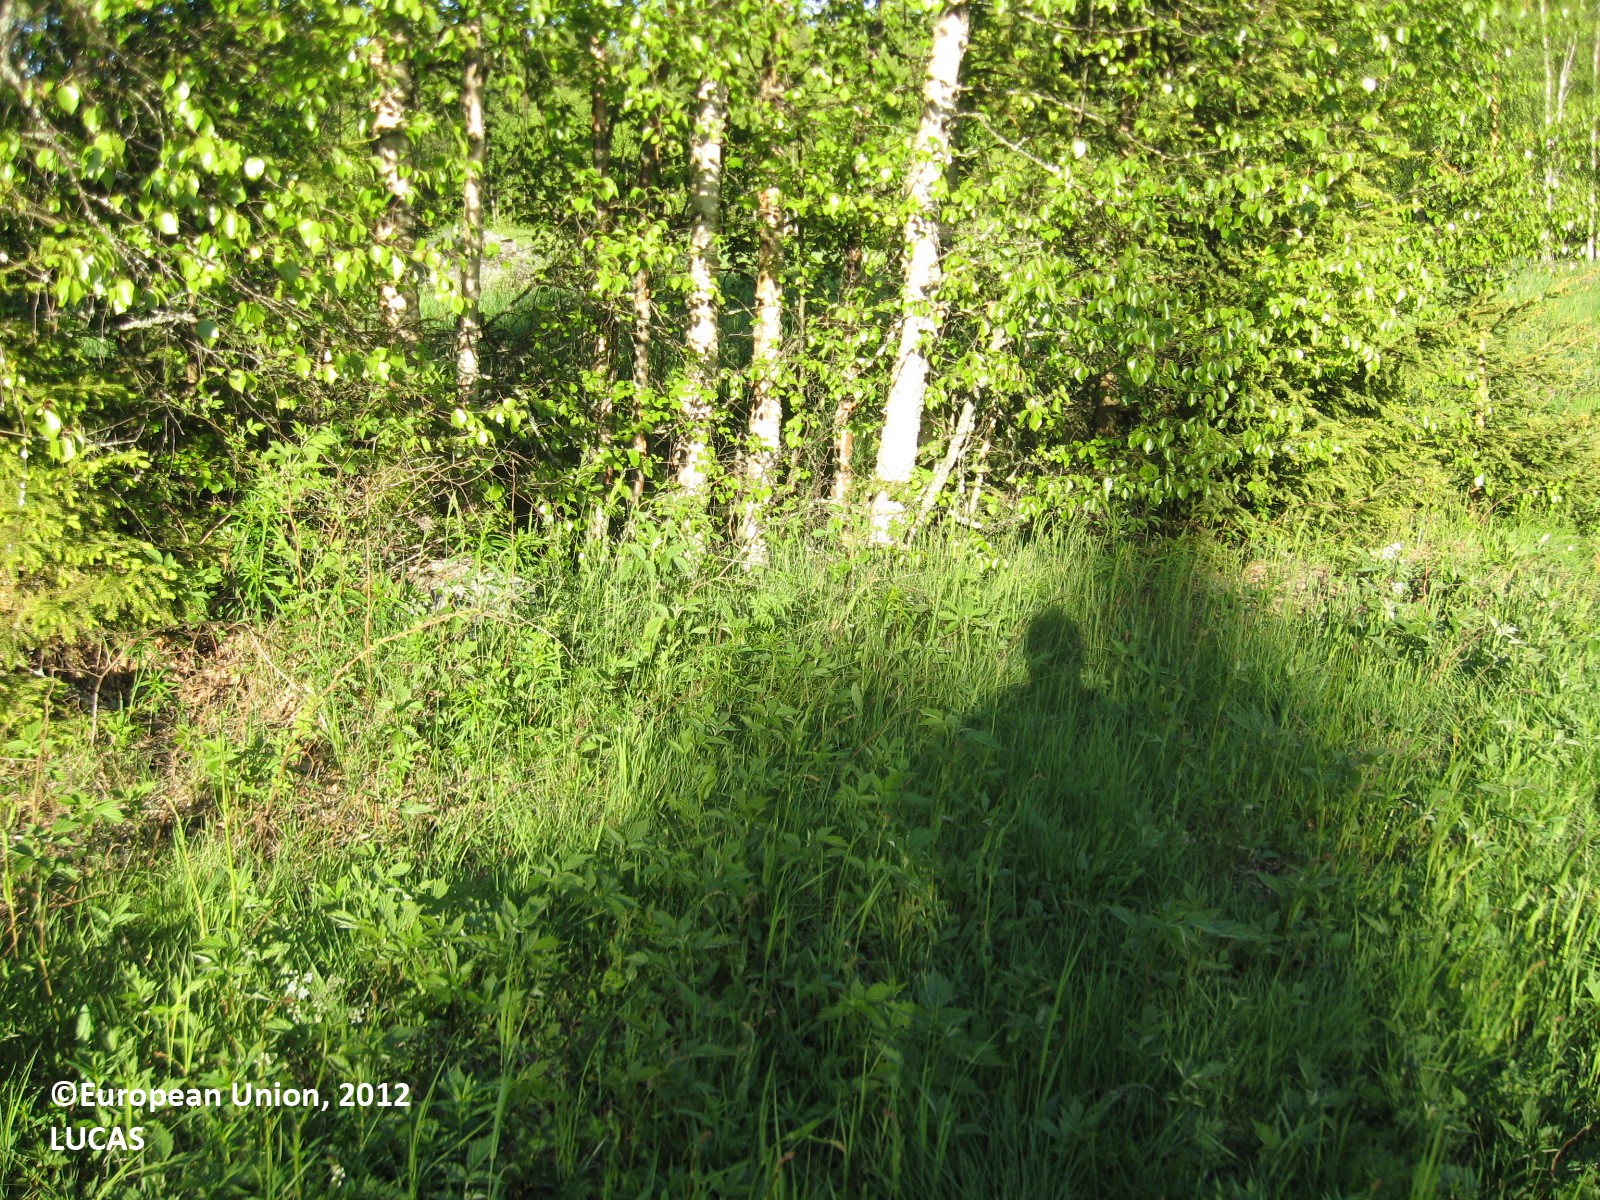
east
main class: Grassland
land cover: Grassland without tree/shrub cover
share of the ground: > 75 %
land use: Agriculture (excluding fallow land and kitchen gardens)
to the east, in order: Grassland without tree/shrub cover; Lines of trees; Ditches and canals; Temporary grasslands; Ditches and canals; Temporary grasslands; Artificial constructions in urban areas; Temporary grasslands; Ditches and canals; Spruce dominated mixed woodland; Oats; Ditches and canals; Lines of trees; Grassland without tree/shrub cover
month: June
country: FI
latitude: 63.1422
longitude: 21.6866
